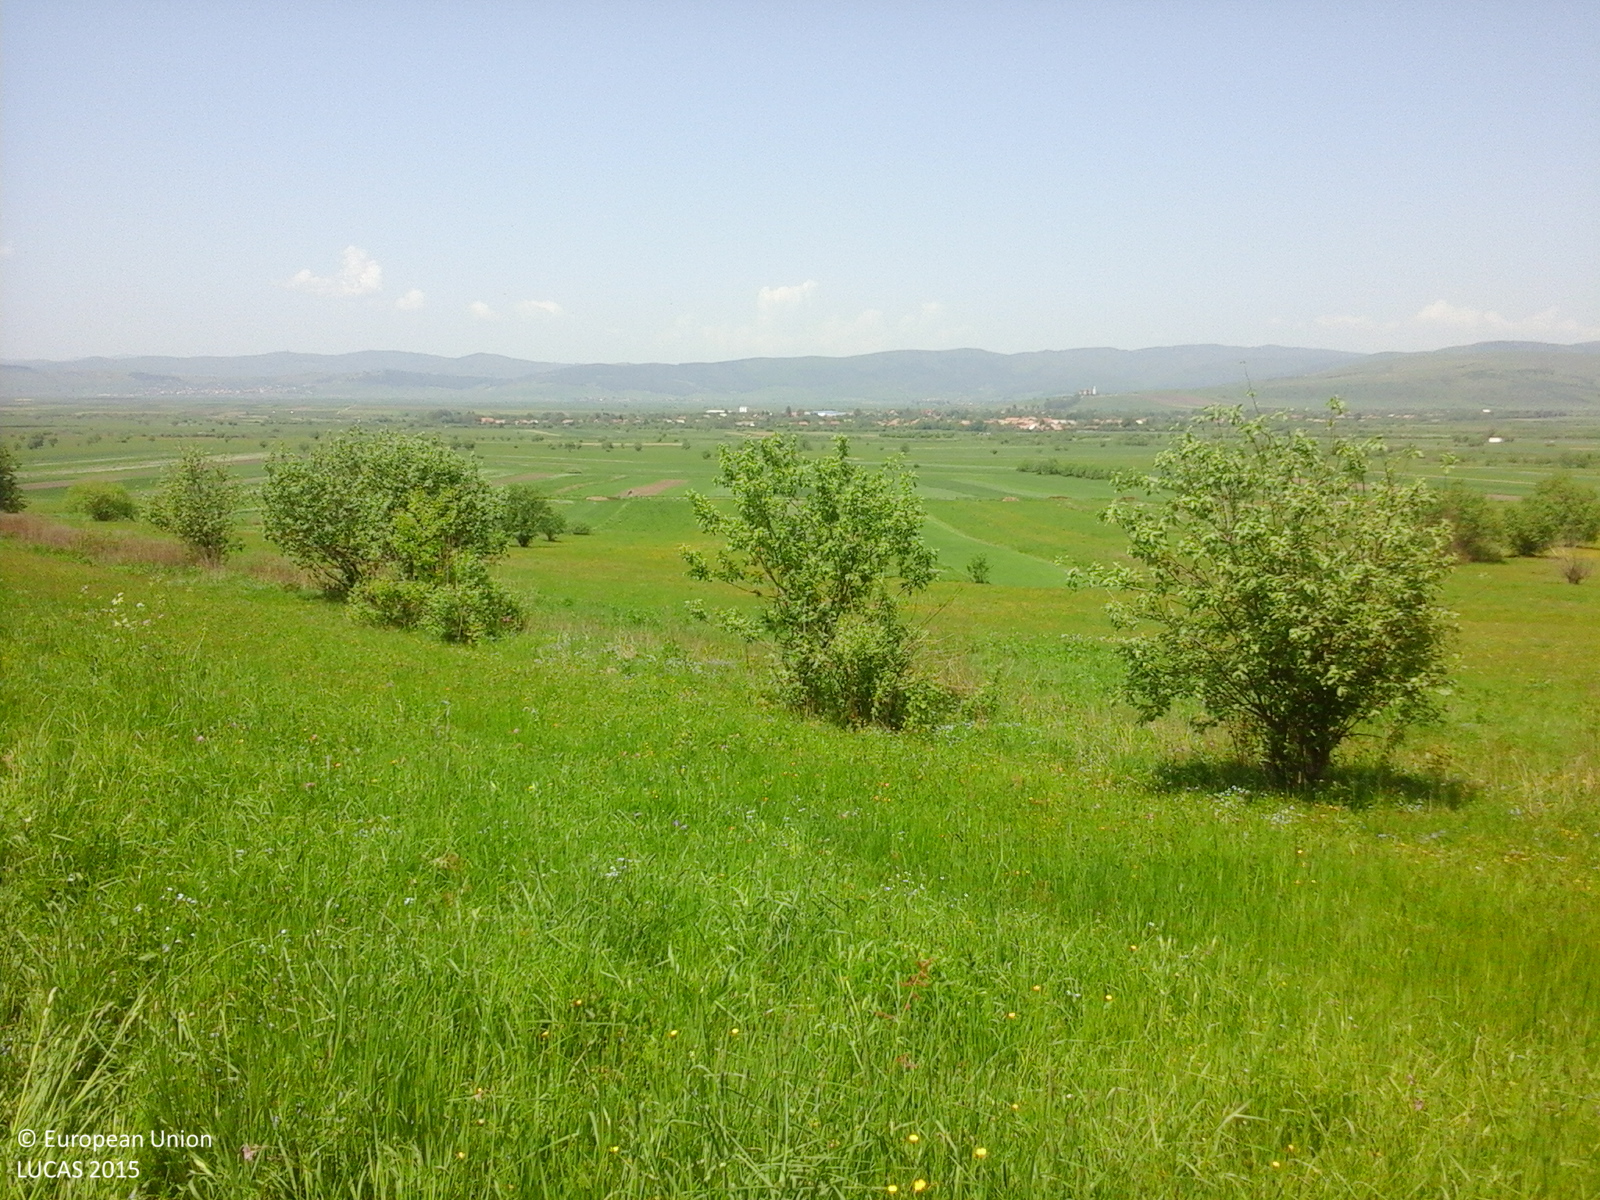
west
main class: Grassland
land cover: Grassland without tree/shrub cover
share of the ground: > 75 %
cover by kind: herbaceous plants 100 %
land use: Agriculture (excluding fallow land and kitchen gardens)
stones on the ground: < 10 %
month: May
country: RO
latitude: 46.0286
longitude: 26.2864
